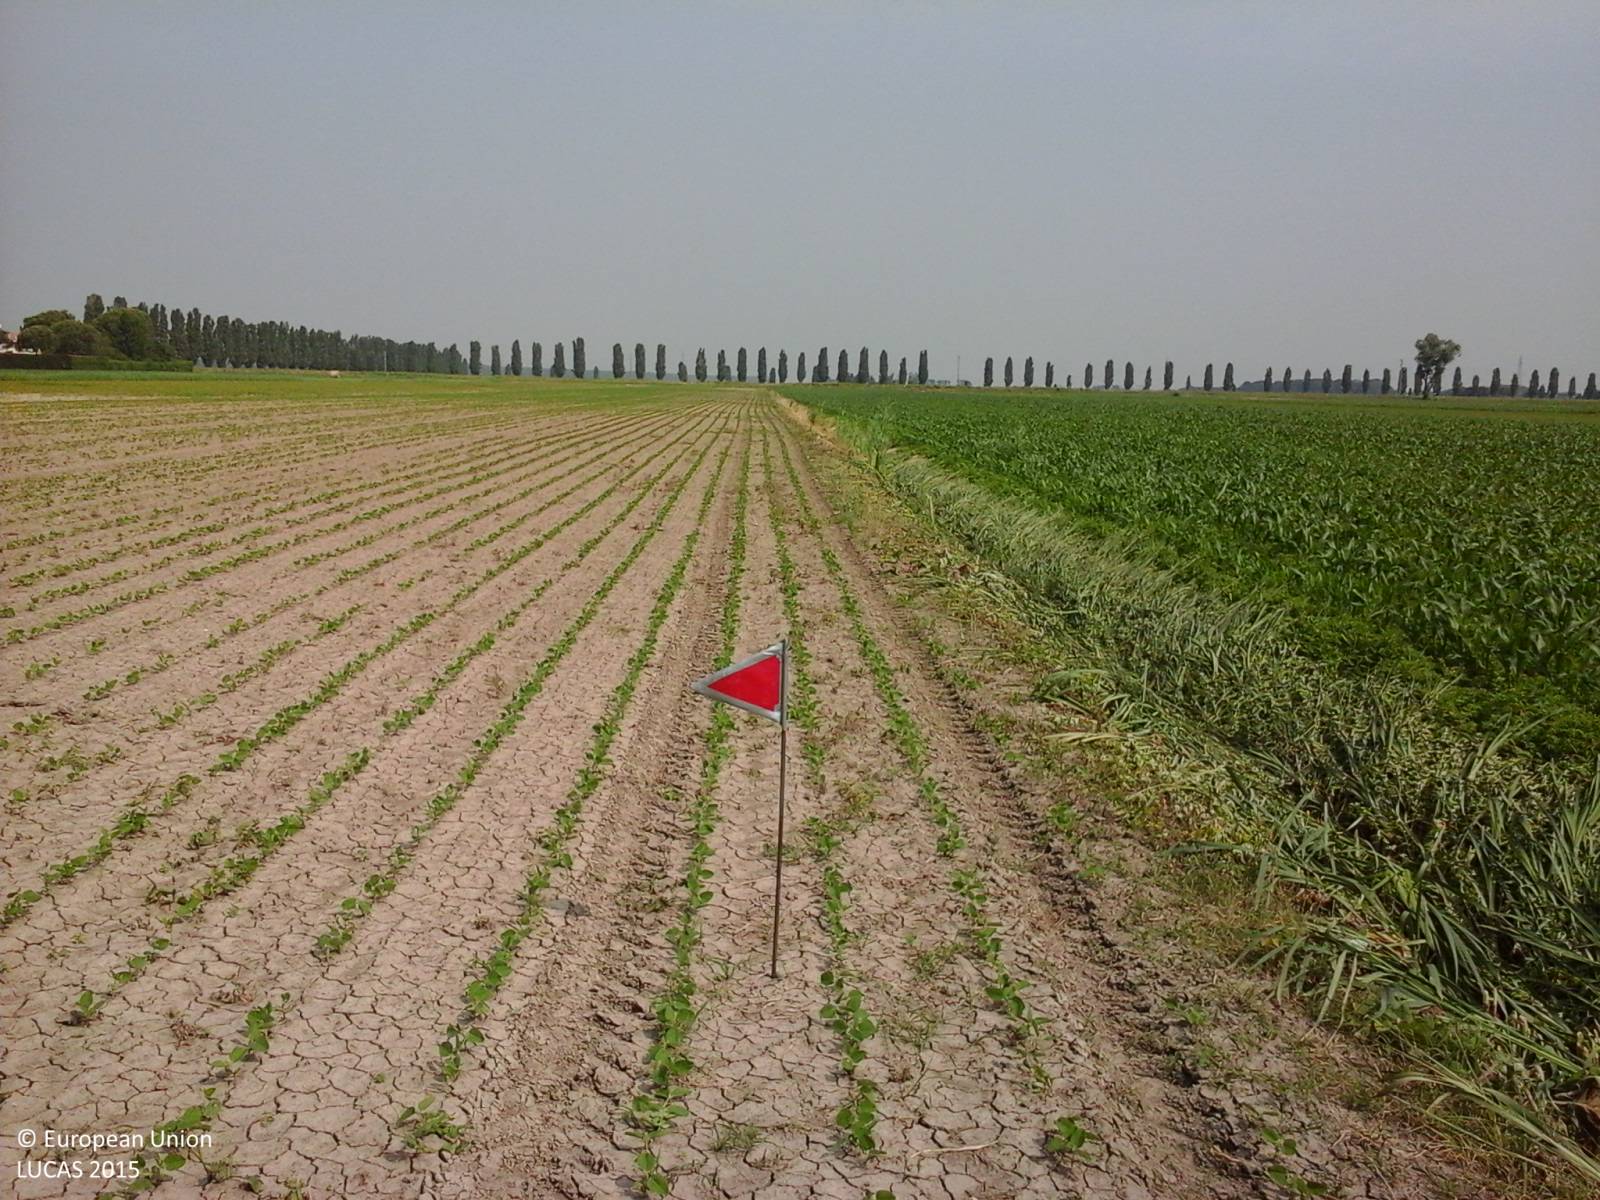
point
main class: Cropland
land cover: Soya
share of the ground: < 10 %
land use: Agriculture (excluding fallow land and kitchen gardens)
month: May
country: IT
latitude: 45.7594
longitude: 13.3001
